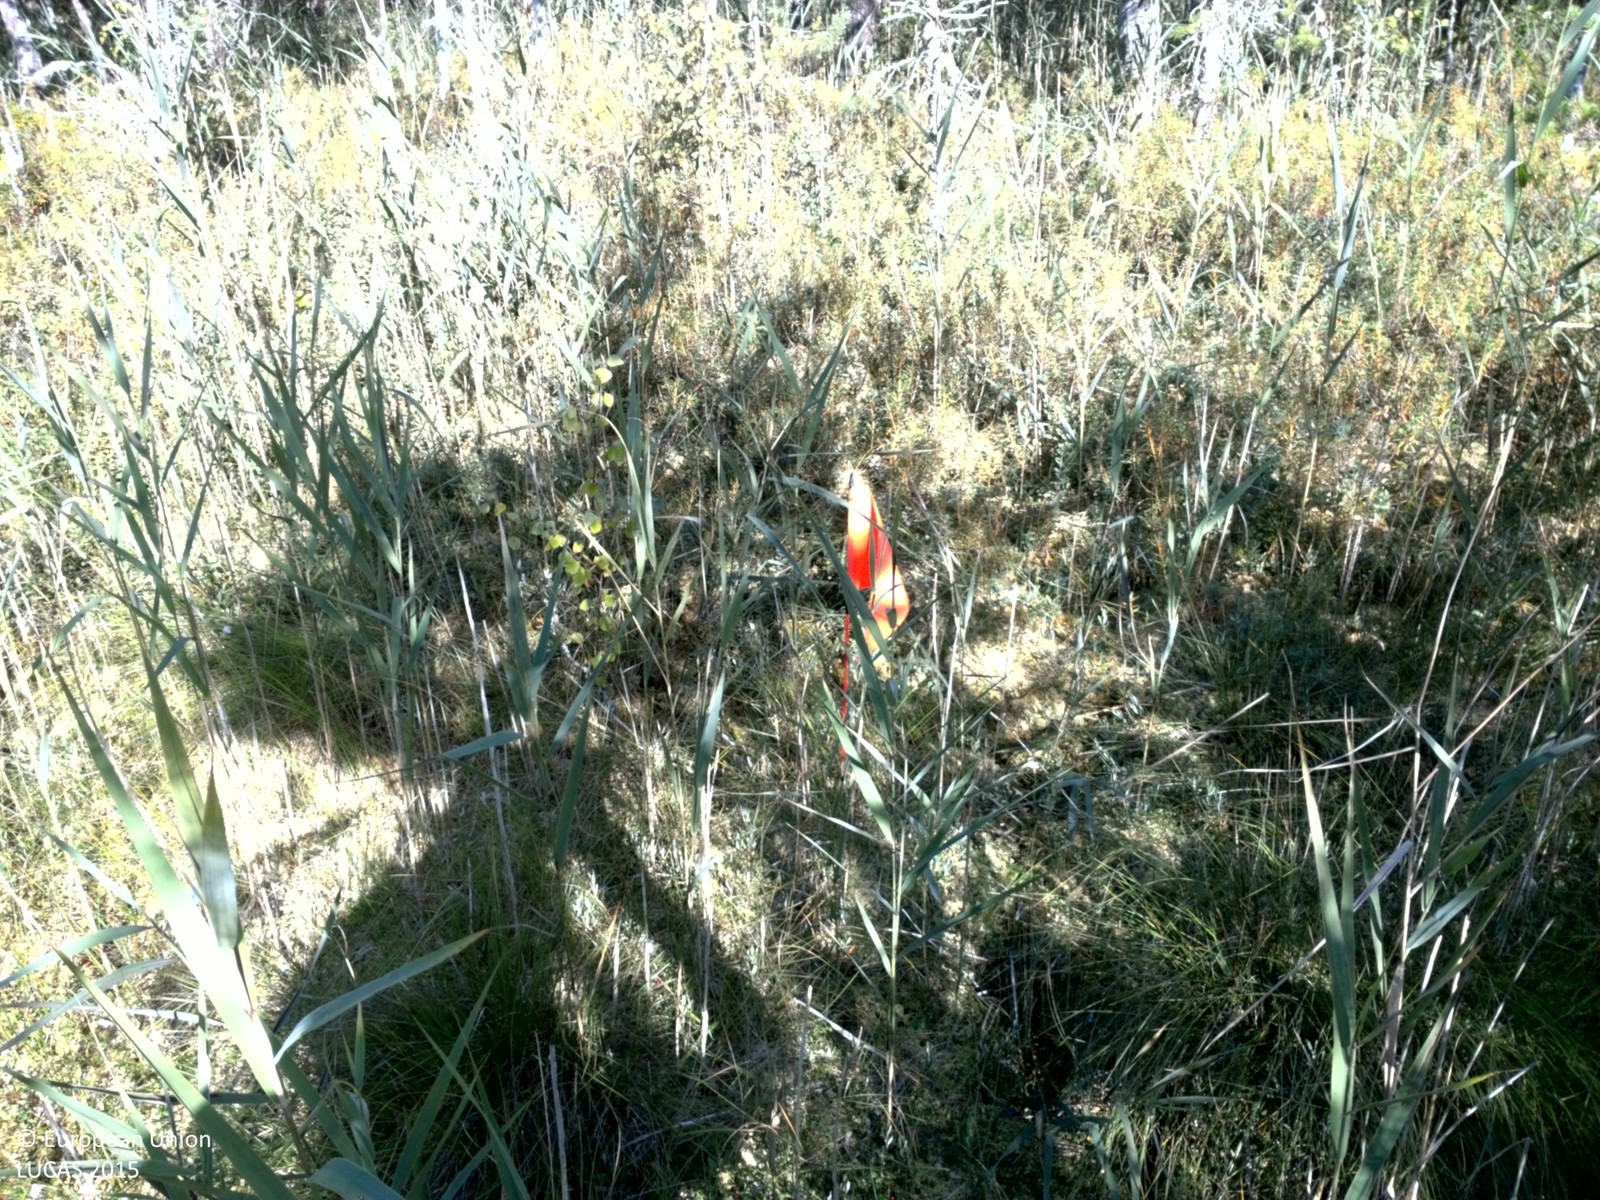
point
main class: Woodland
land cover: Pine dominated coniferous woodland
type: boreal forest
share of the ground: 25 - 50 %
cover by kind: lichens and mosses 55 %, coniferous forest trees 30 %, herbaceous plants 10 %, shrubs 5 %
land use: Forestry
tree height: < 5 m
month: August
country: SE
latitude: 59.7867
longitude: 17.7449
